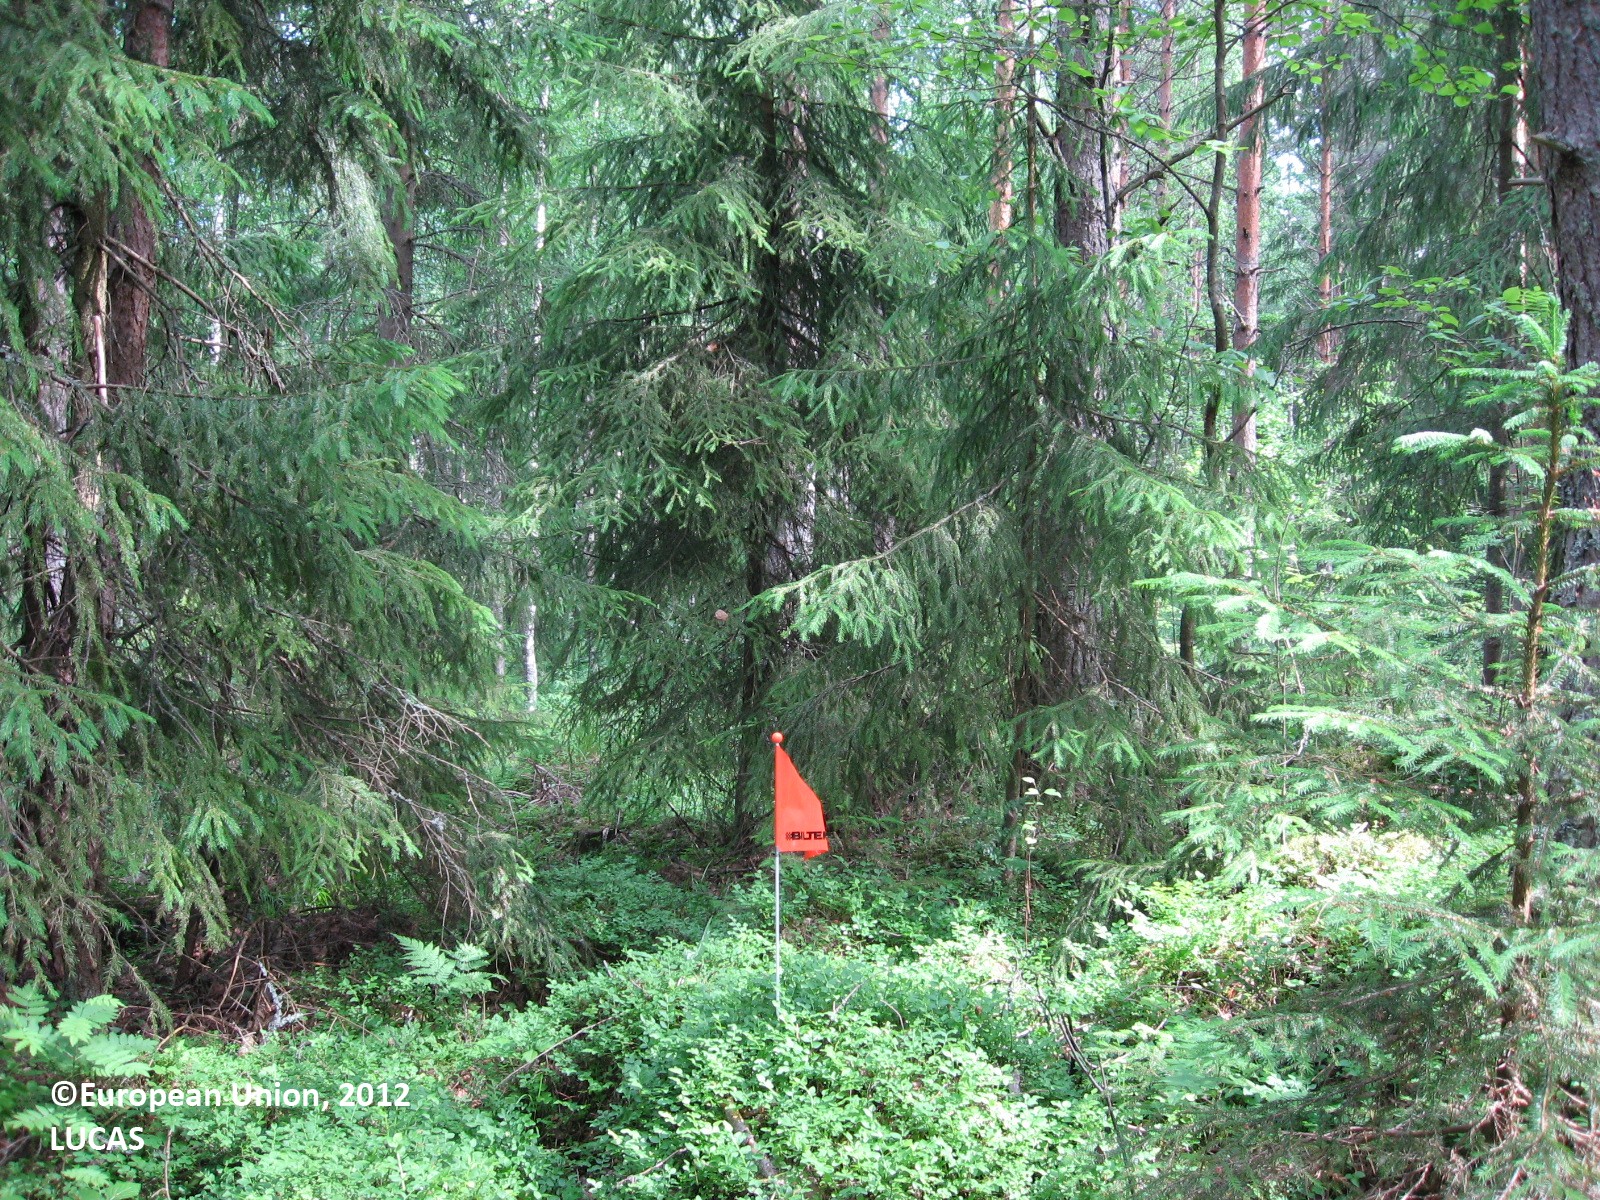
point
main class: Woodland
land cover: Other mixed woodland
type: boreal forest
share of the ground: > 75 %
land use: Forestry
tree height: > 5 m
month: June
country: FI
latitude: 60.5407
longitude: 26.5443
